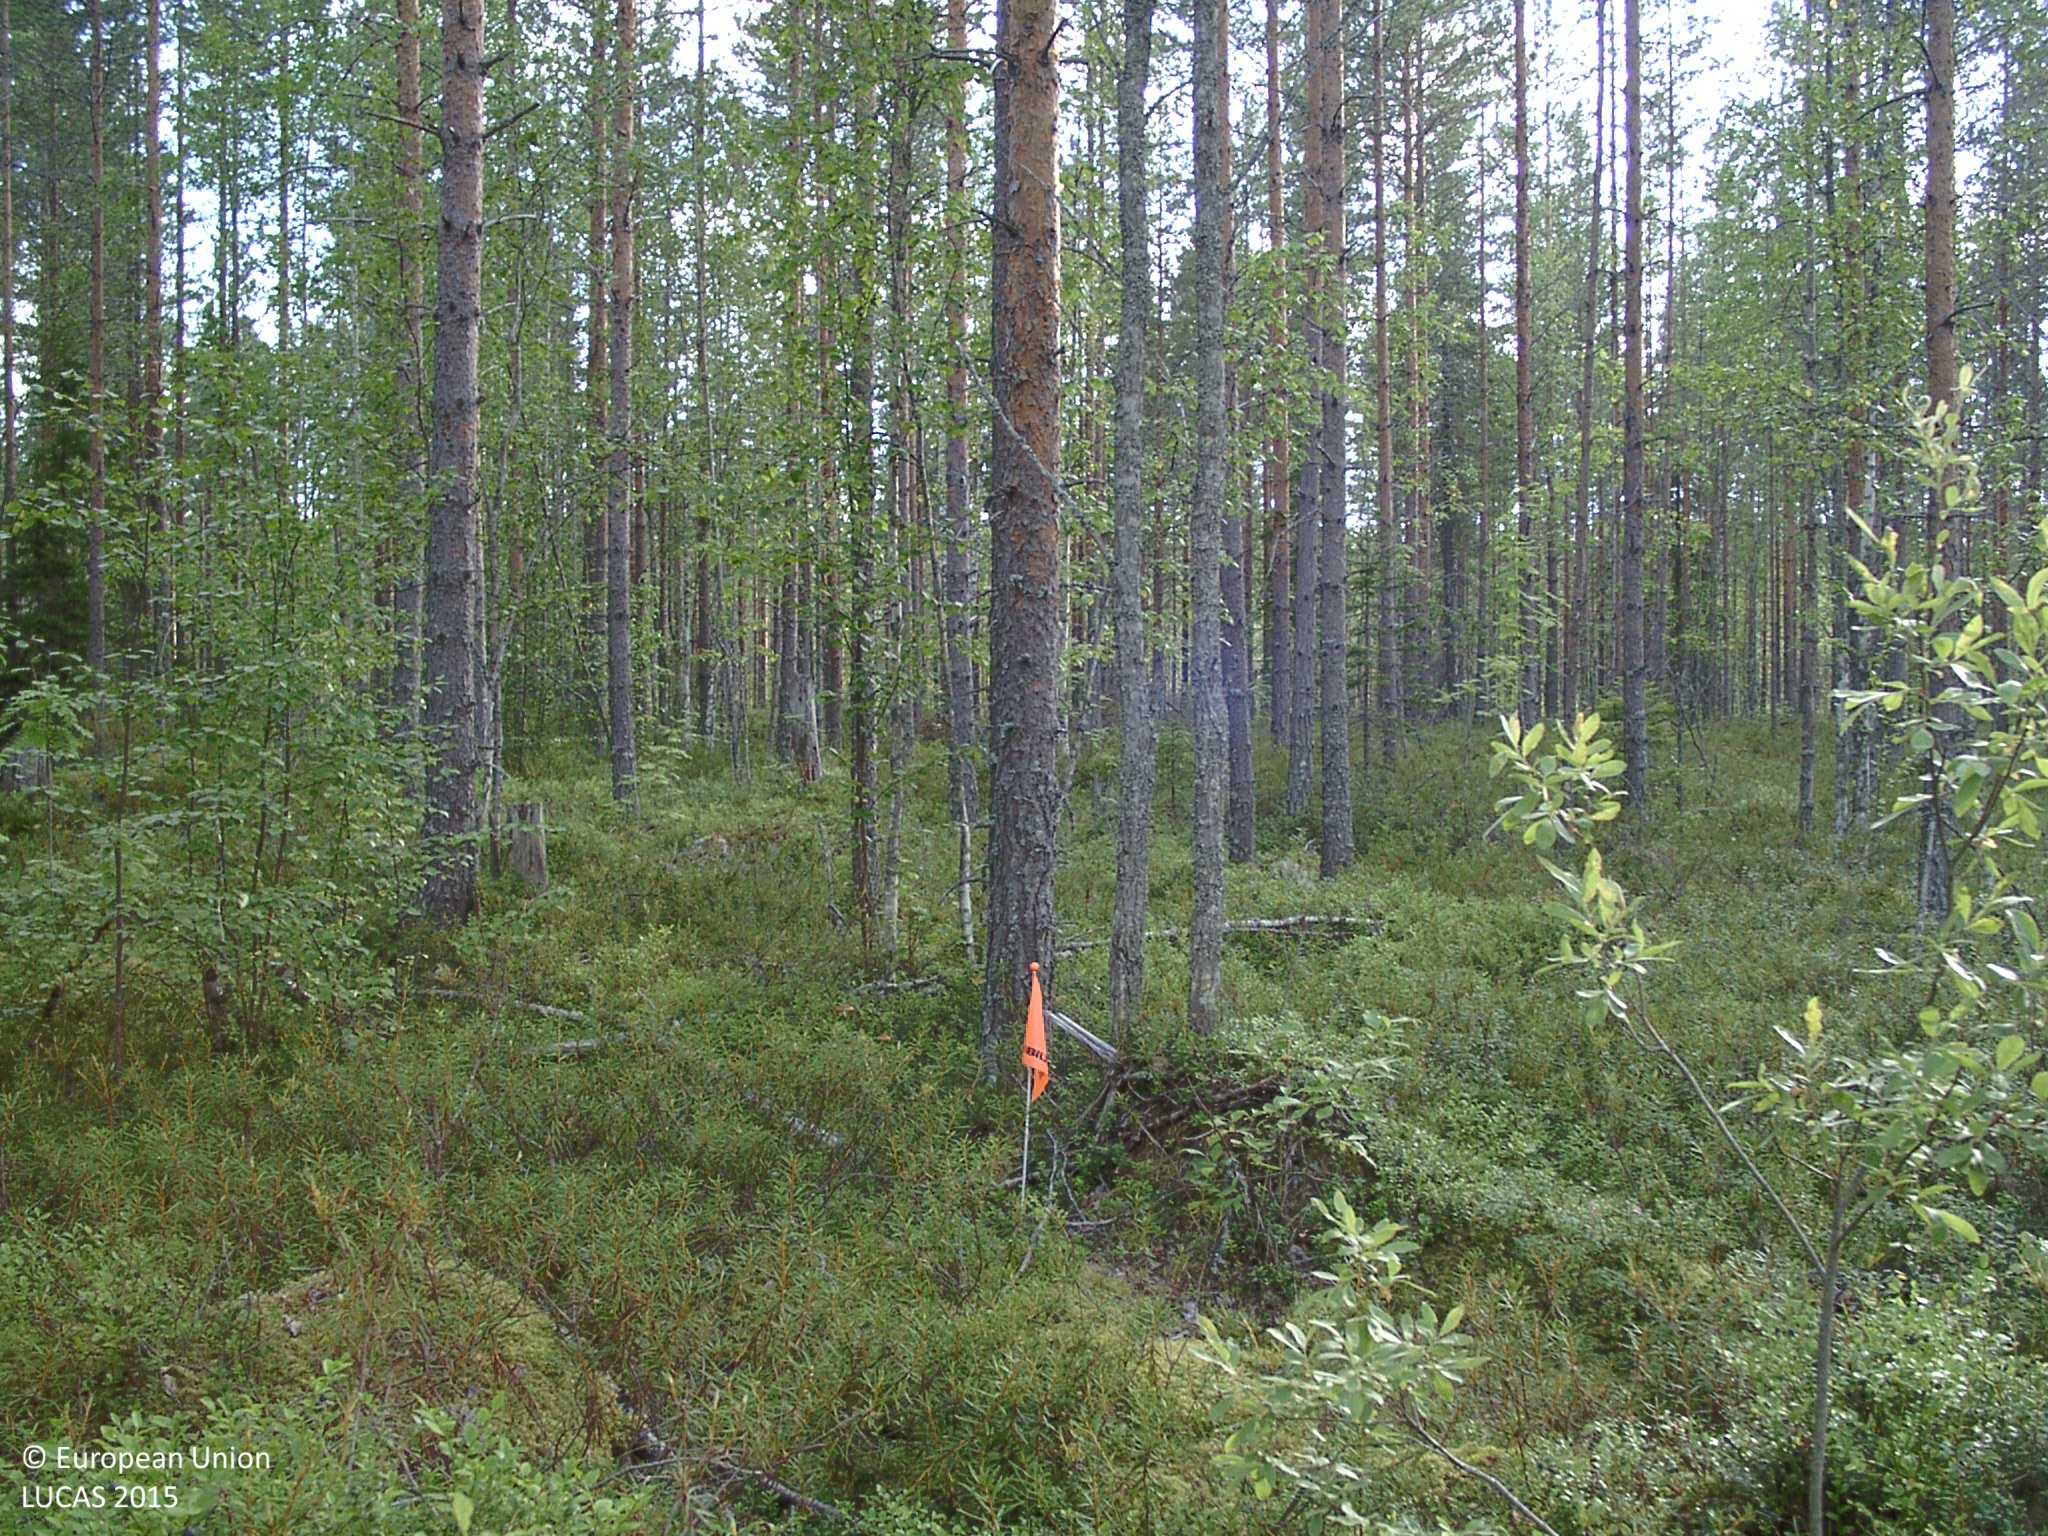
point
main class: Woodland
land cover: Pine dominated mixed woodland
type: boreal forest
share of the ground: 50 - 75 %
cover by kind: coniferous forest trees 45 %, shrubs 25 %, broadleaved forest trees 20 %, lichens and mosses 10 %
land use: Forestry
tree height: > 5 m
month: August
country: FI
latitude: 62.9816
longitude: 25.1539
